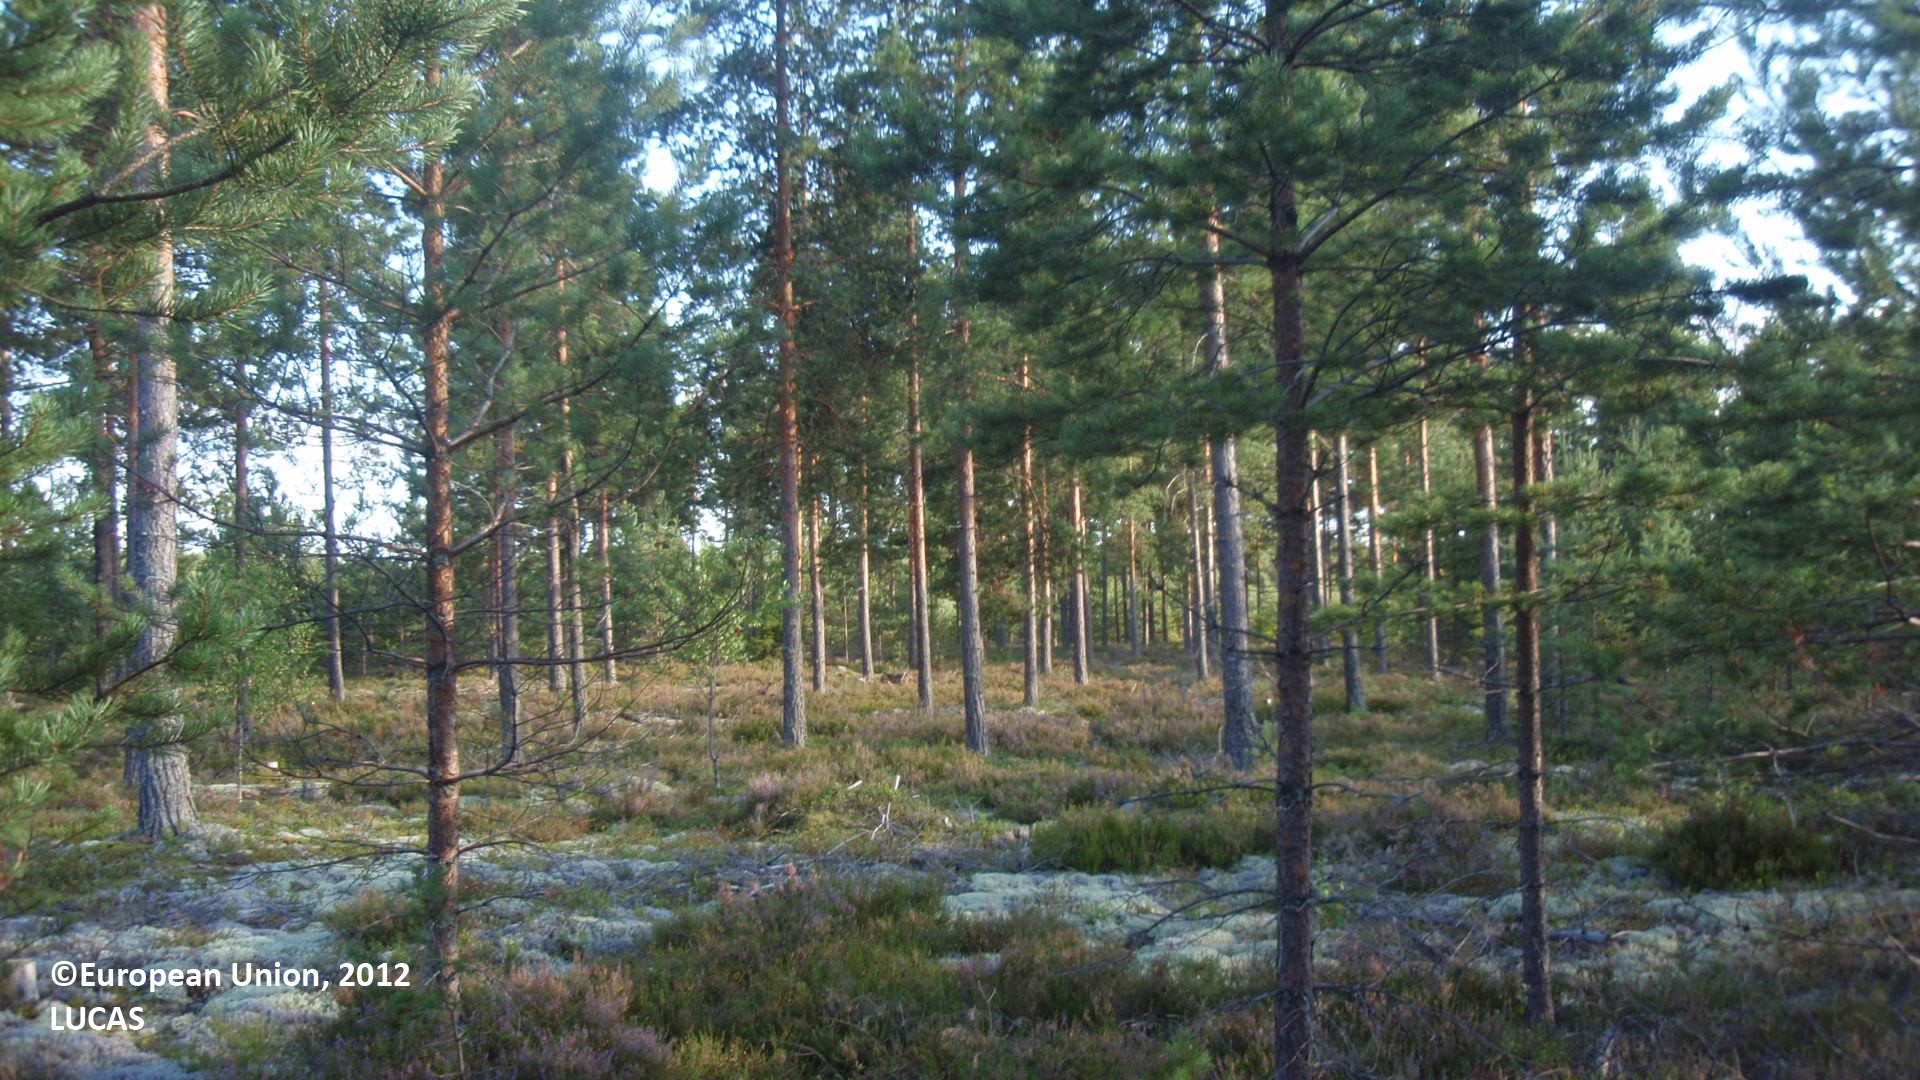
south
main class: Woodland
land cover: Pine dominated coniferous woodland
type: boreal forest
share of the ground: 25 - 50 %
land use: Forestry
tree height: > 5 m
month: August
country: FI
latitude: 60.8113
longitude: 27.5187
